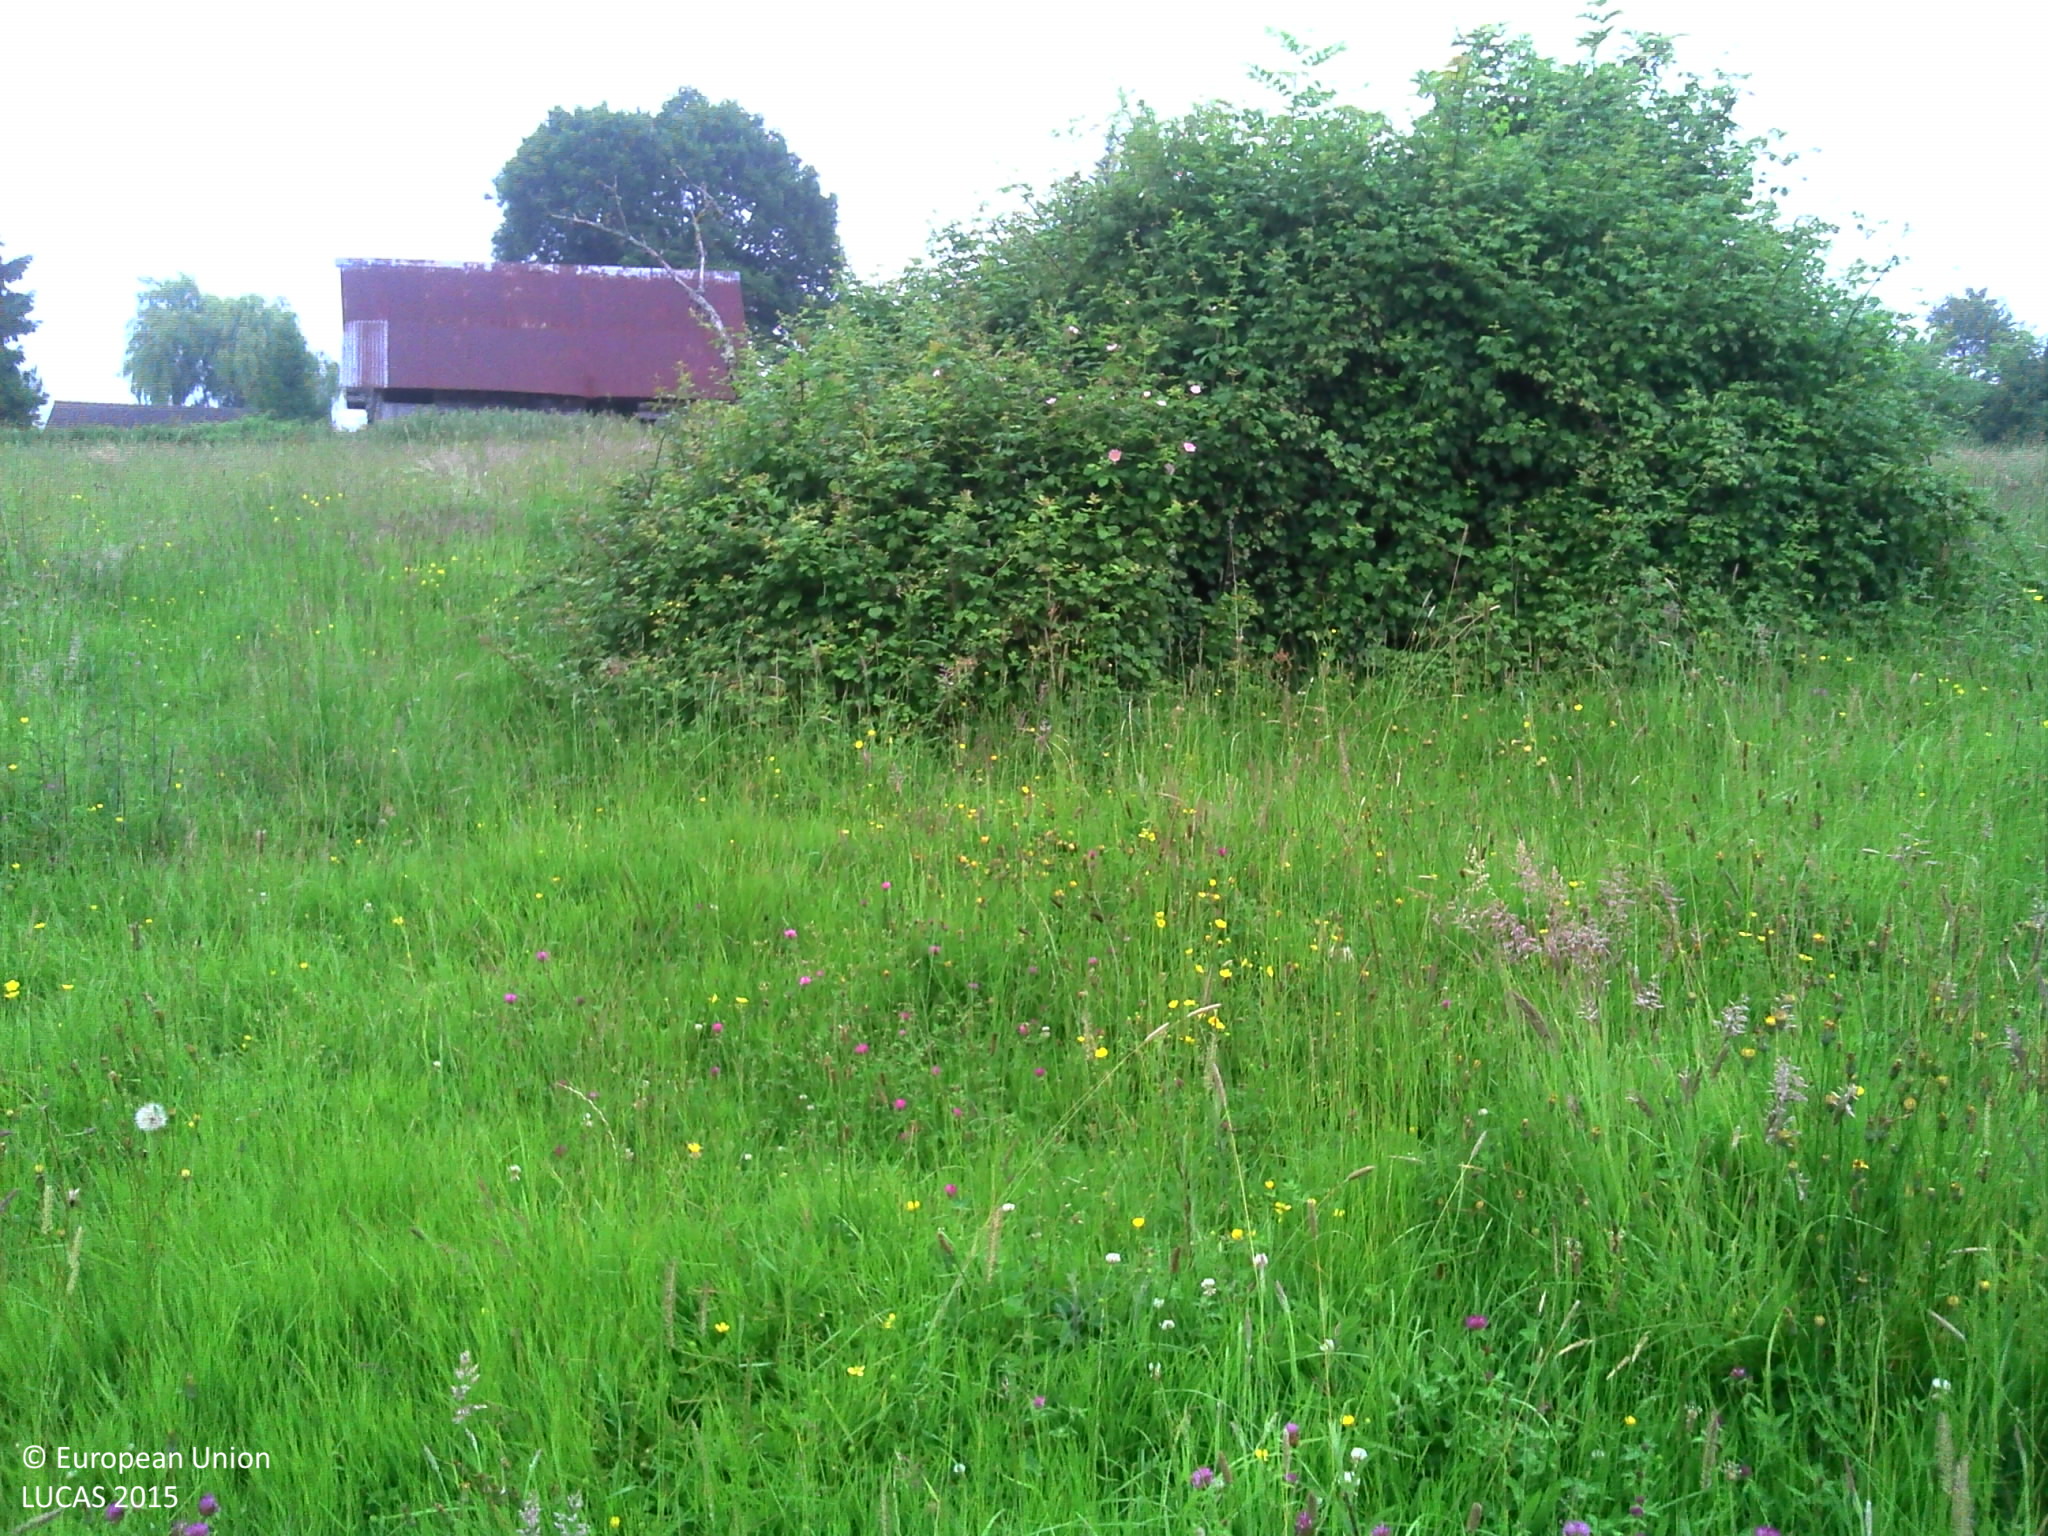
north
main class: Grassland
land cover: Grassland with sparse tree/shrub cover
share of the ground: > 75 %
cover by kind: herbaceous plants 95 %, broadleaved forest trees 5 %
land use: Agriculture (excluding fallow land and kitchen gardens)
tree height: > 5 m
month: June
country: FR
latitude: 49.2395
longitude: 0.0388
